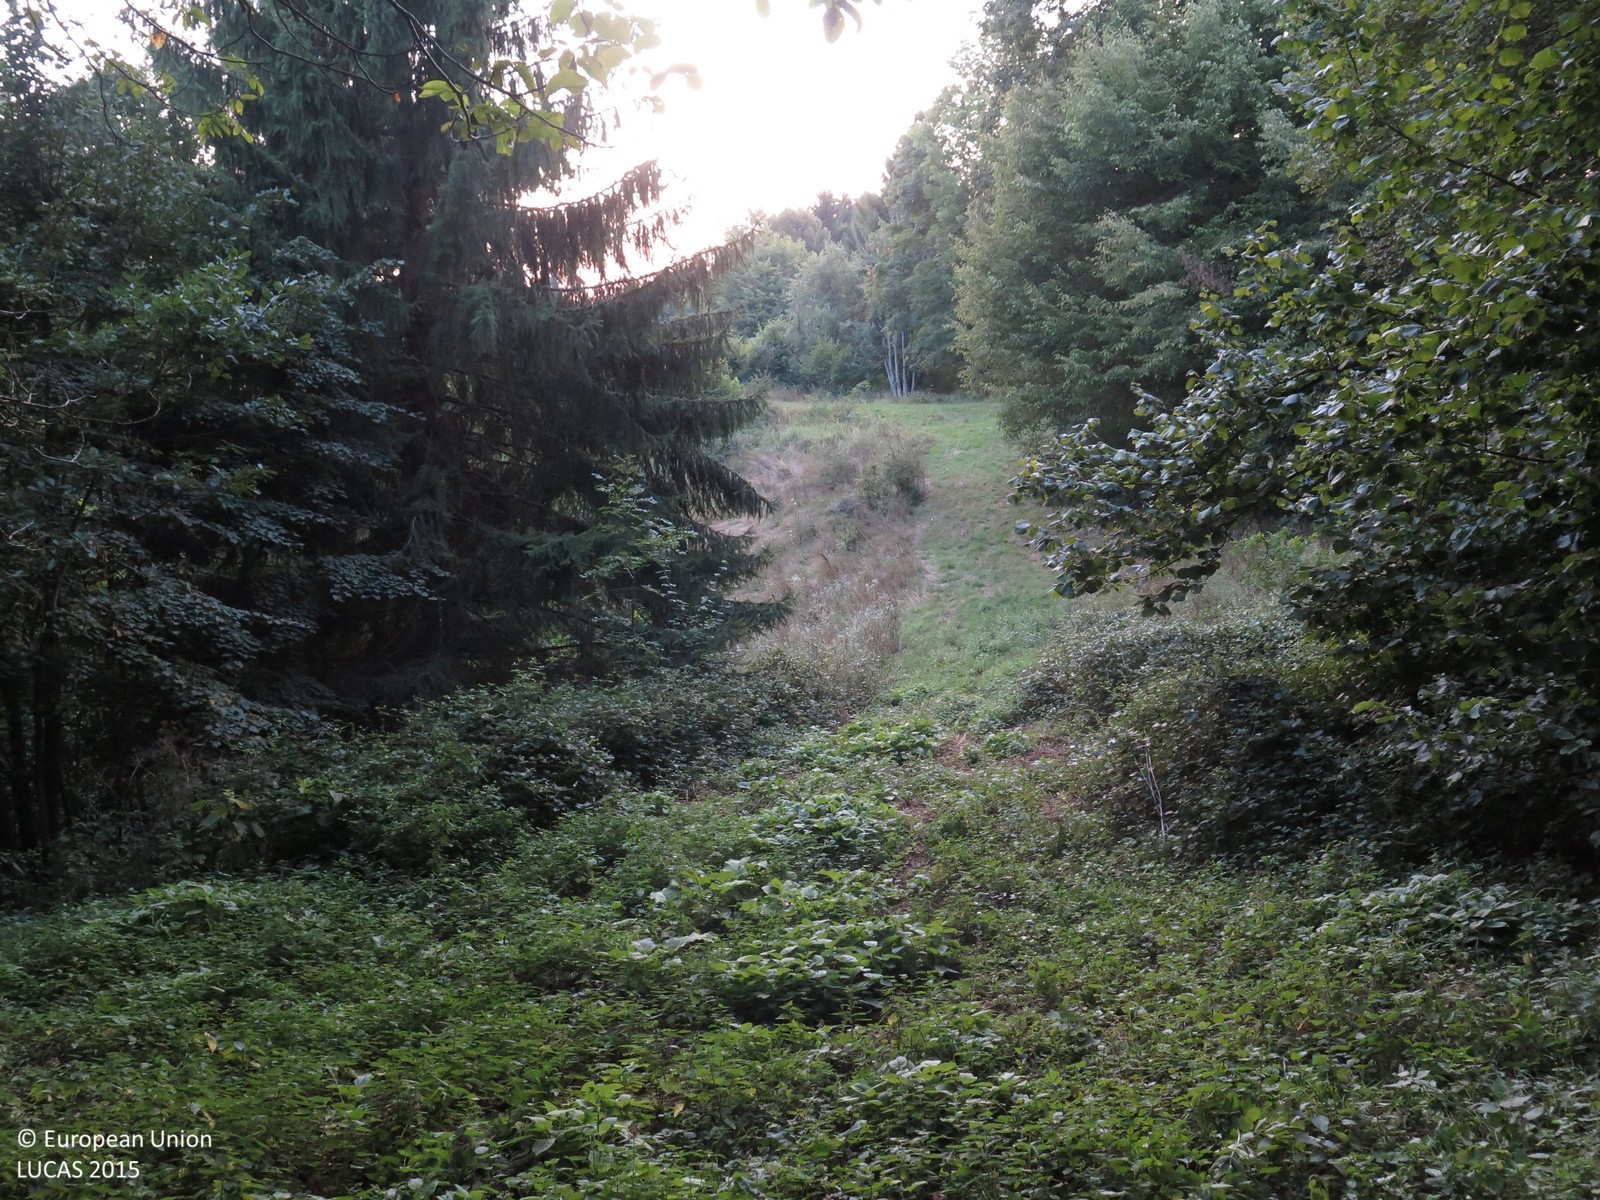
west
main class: Grassland
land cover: Grassland with sparse tree/shrub cover
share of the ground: > 75 %
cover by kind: herbaceous plants 95 %, broadleaved forest trees 5 %
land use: Semi-natural and natural areas not in use
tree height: > 5 m
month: August
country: HR
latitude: 45.5159
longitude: 14.9241
